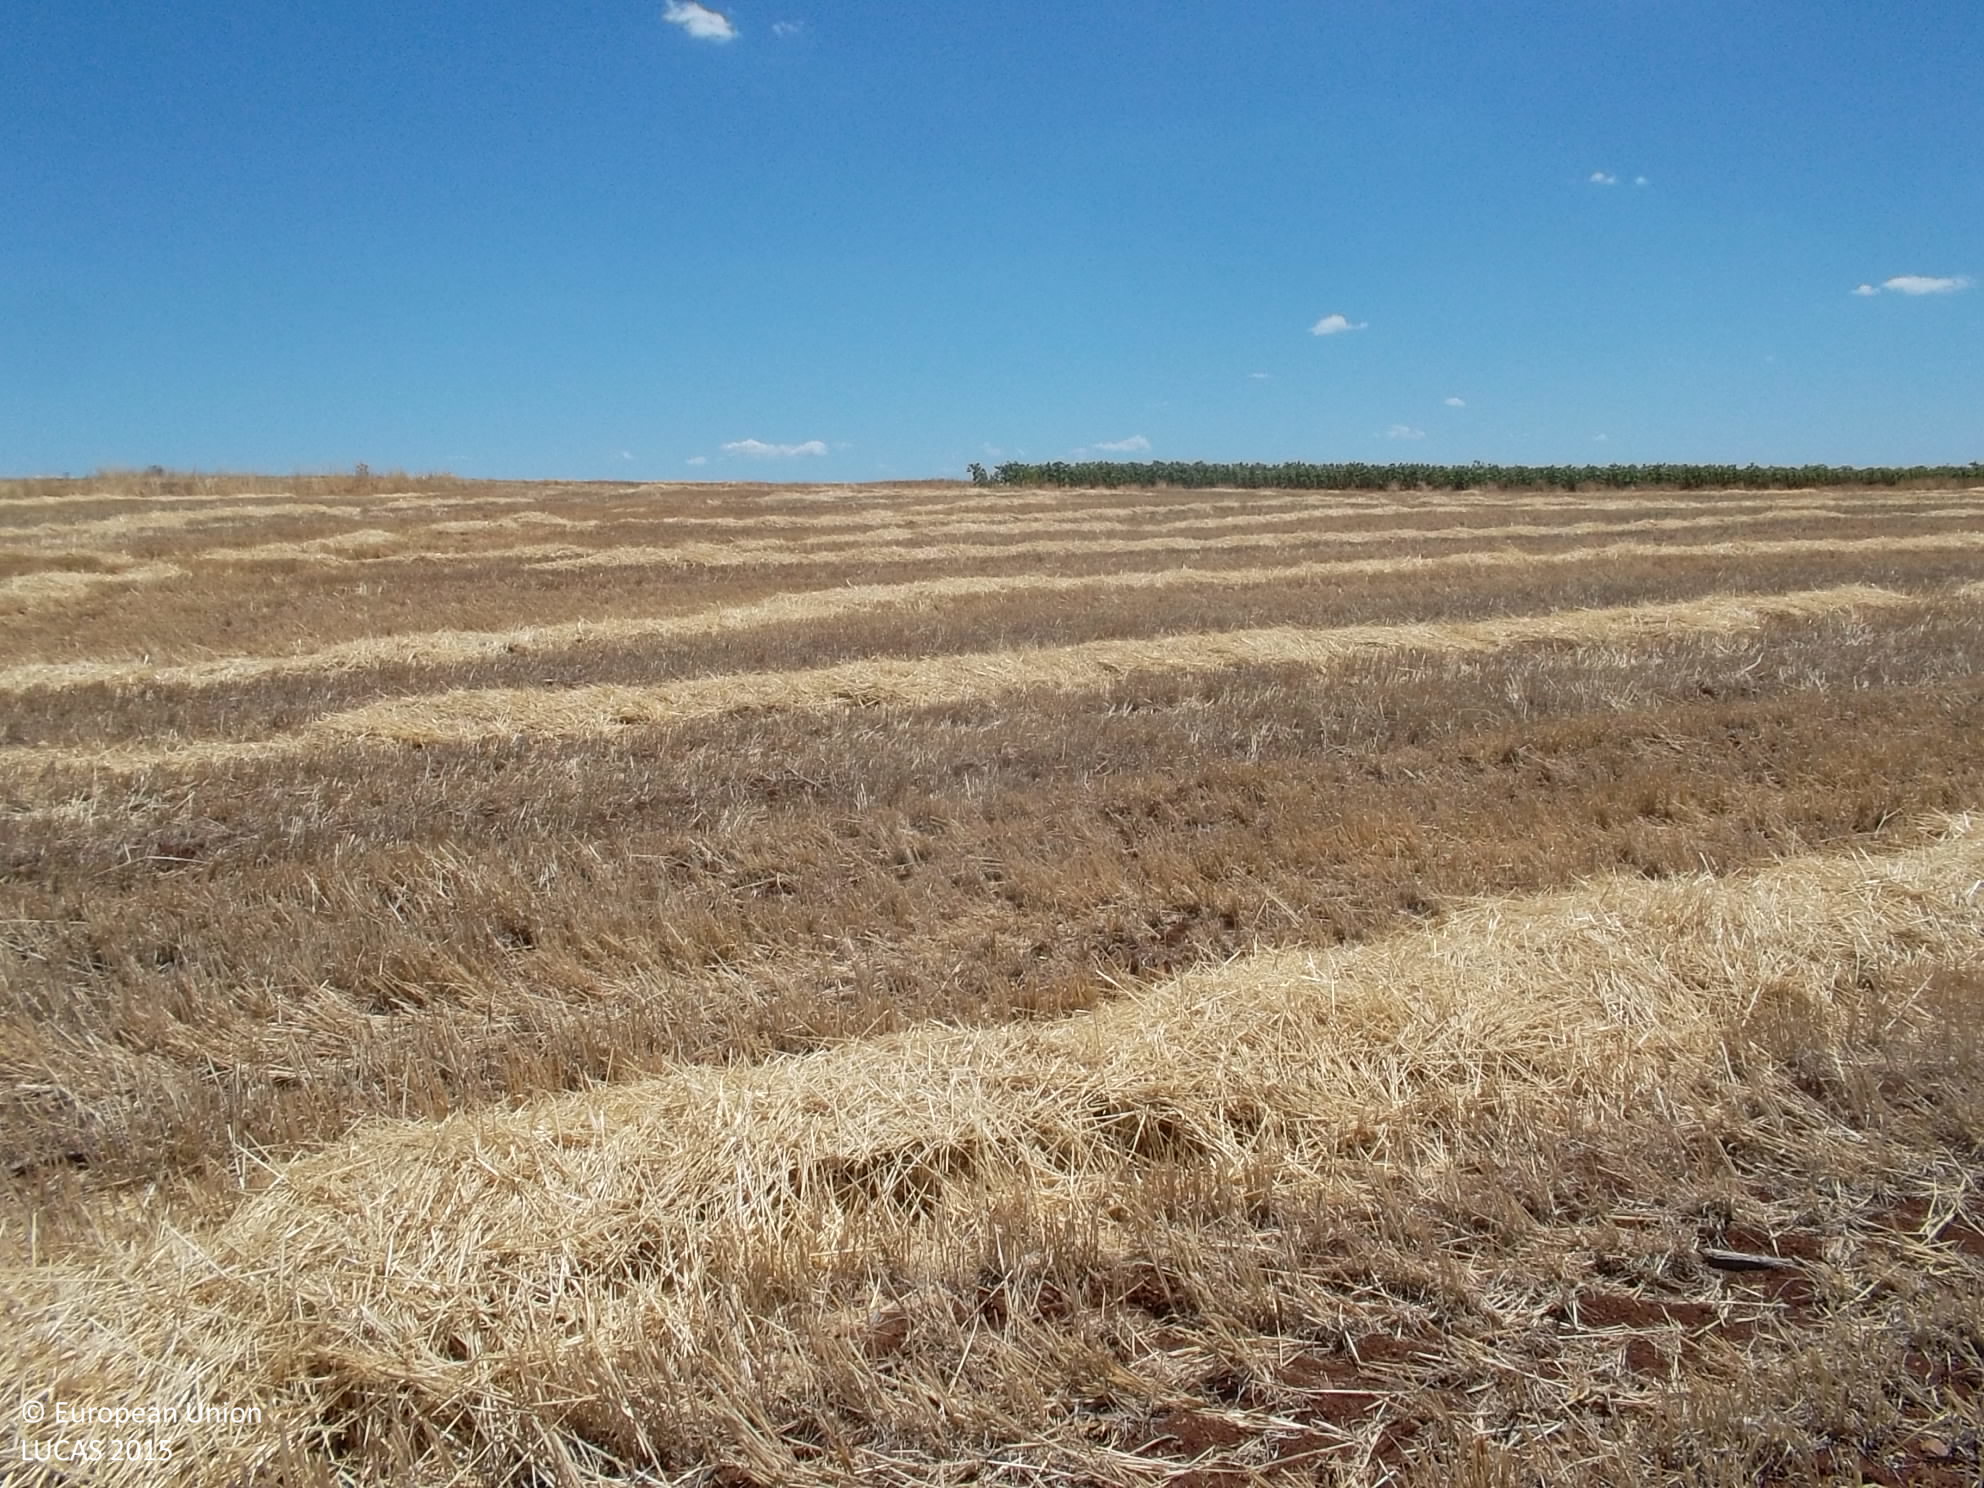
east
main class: Cropland
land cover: Barley
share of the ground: < 10 %
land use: Agriculture (excluding fallow land and kitchen gardens)
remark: Harvested field
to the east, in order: Barley; Grass margins; Barley; Grass margins; Tracks; Other bare soil; Grass margins; Other bare soil
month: July
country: ES
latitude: 38.3316
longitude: -5.8132
